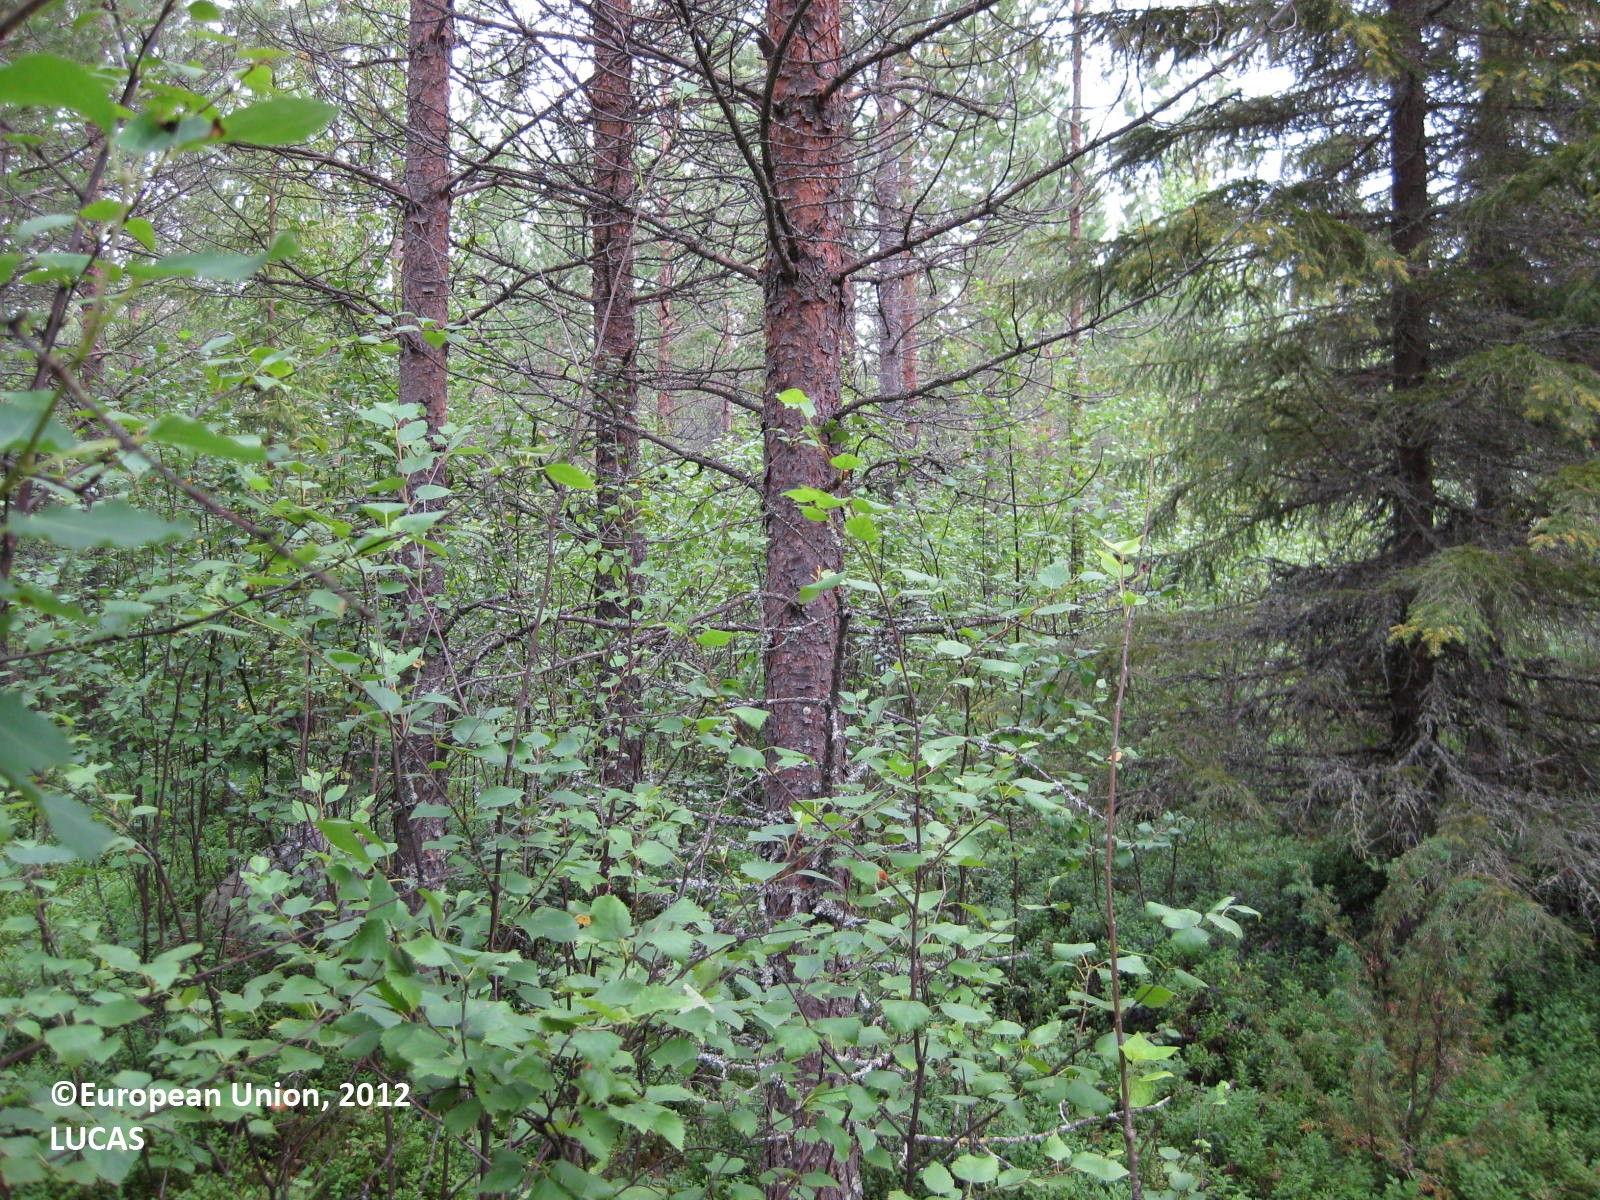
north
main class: Woodland
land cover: Pine dominated mixed woodland
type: boreal forest
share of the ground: > 75 %
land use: Forestry
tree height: > 5 m
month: July
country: FI
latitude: 65.7900
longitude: 28.5827
